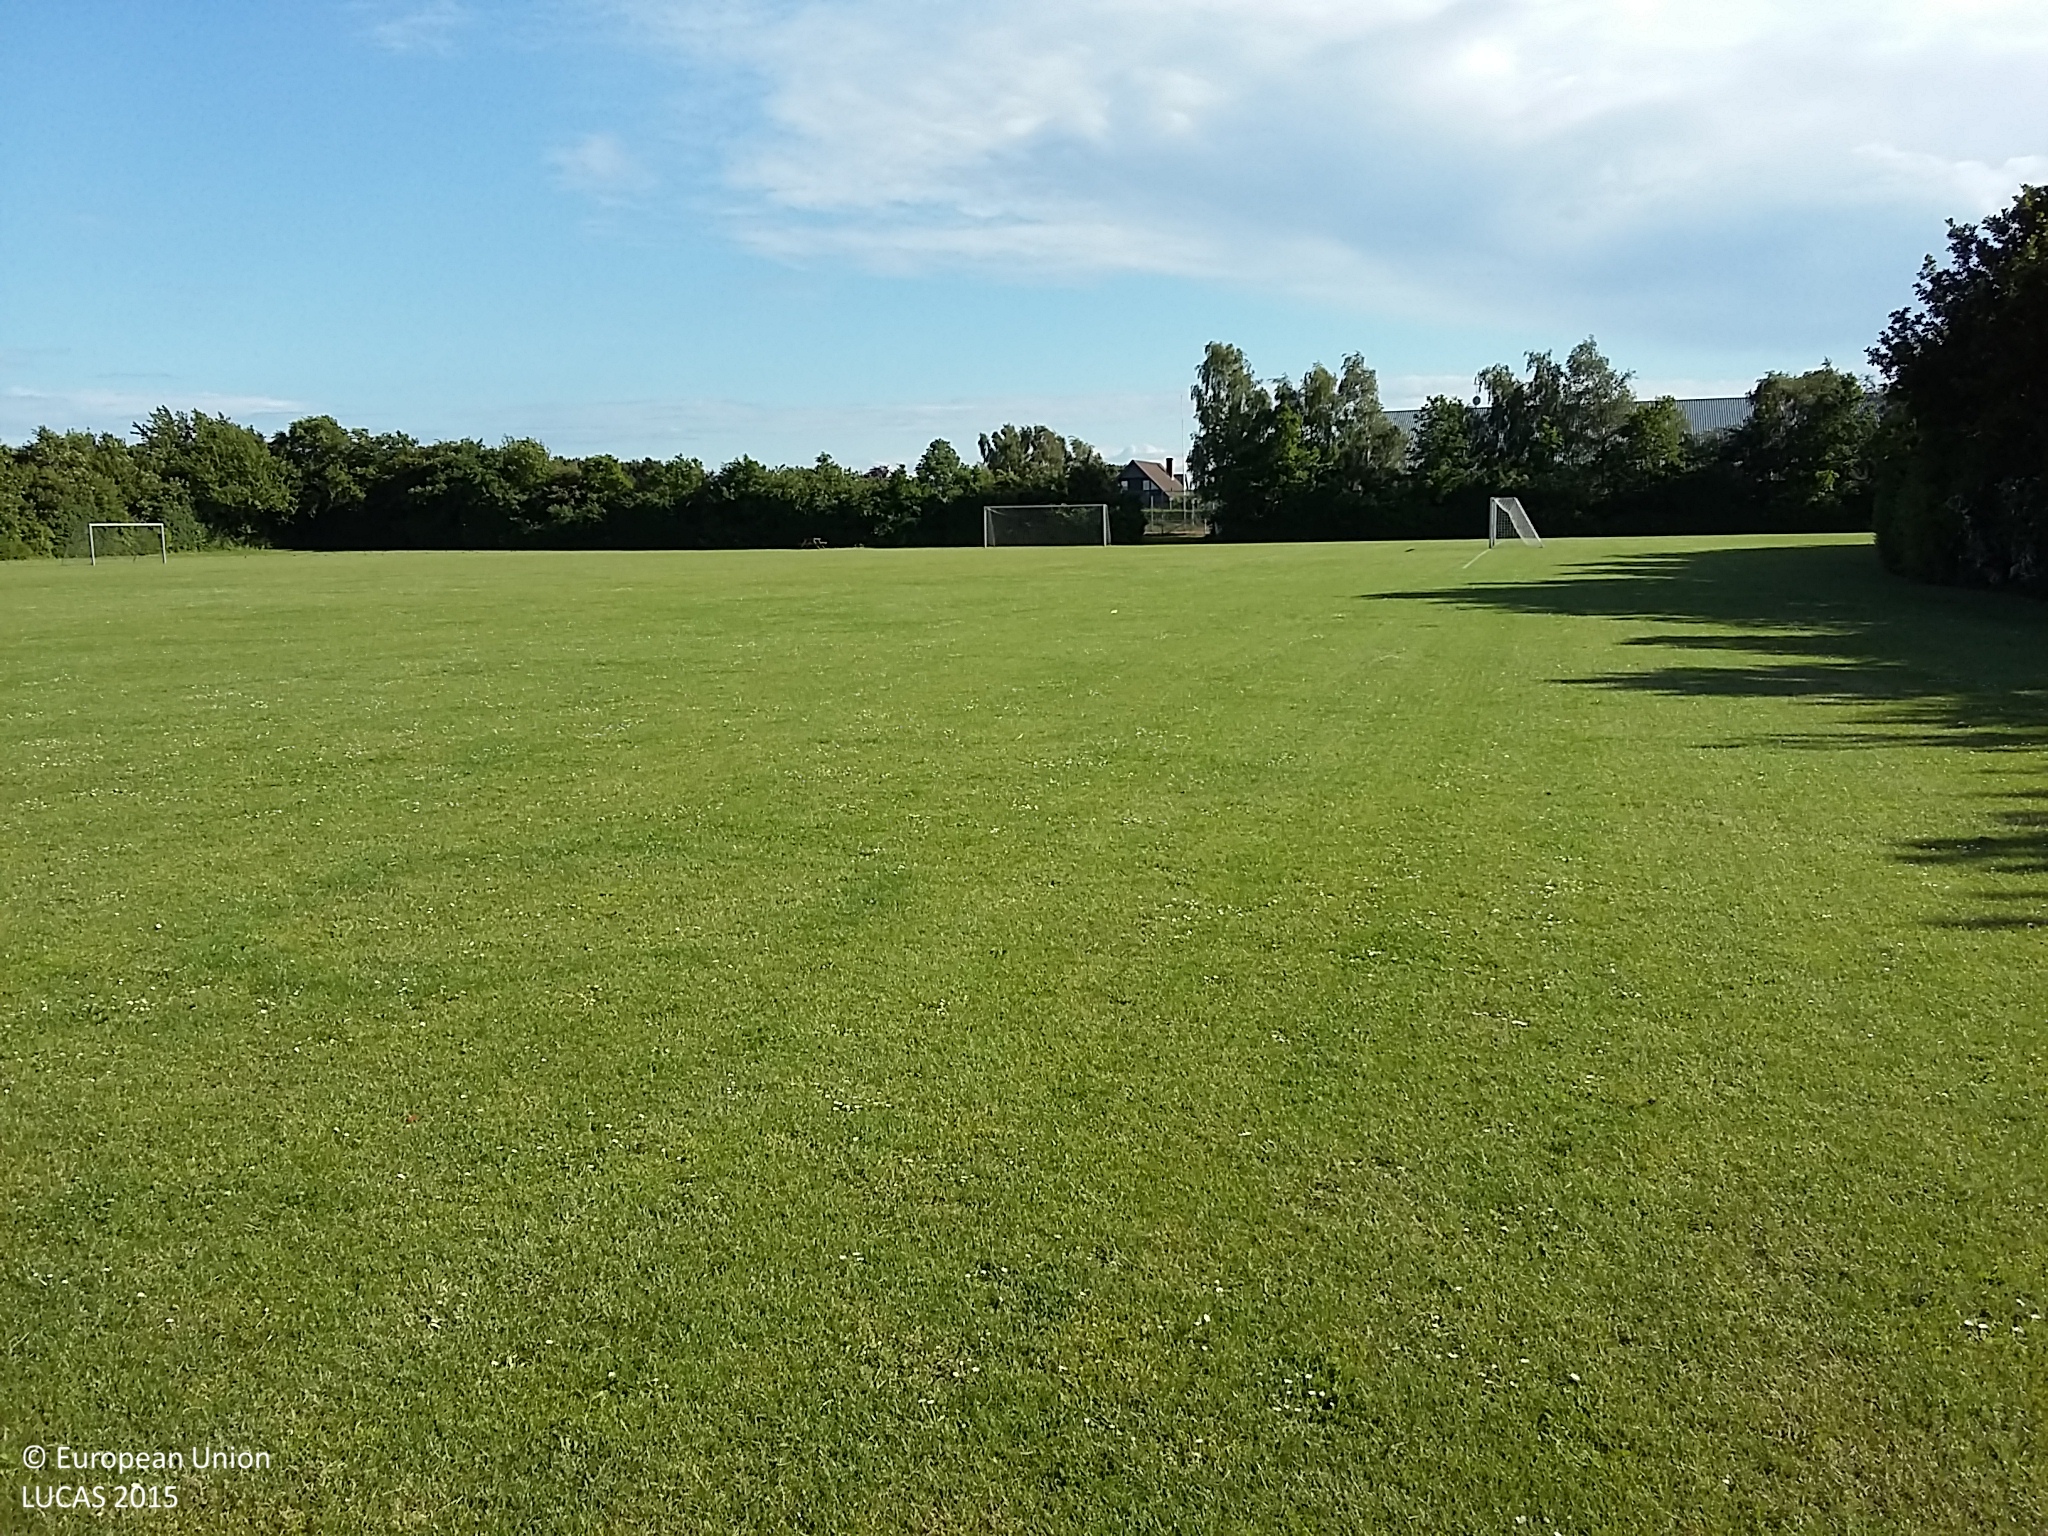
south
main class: Grassland
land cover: Grassland without tree/shrub cover
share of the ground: > 75 %
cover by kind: herbaceous plants 100 %
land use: Sport
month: June
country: DK
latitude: 54.7627
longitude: 11.1337
